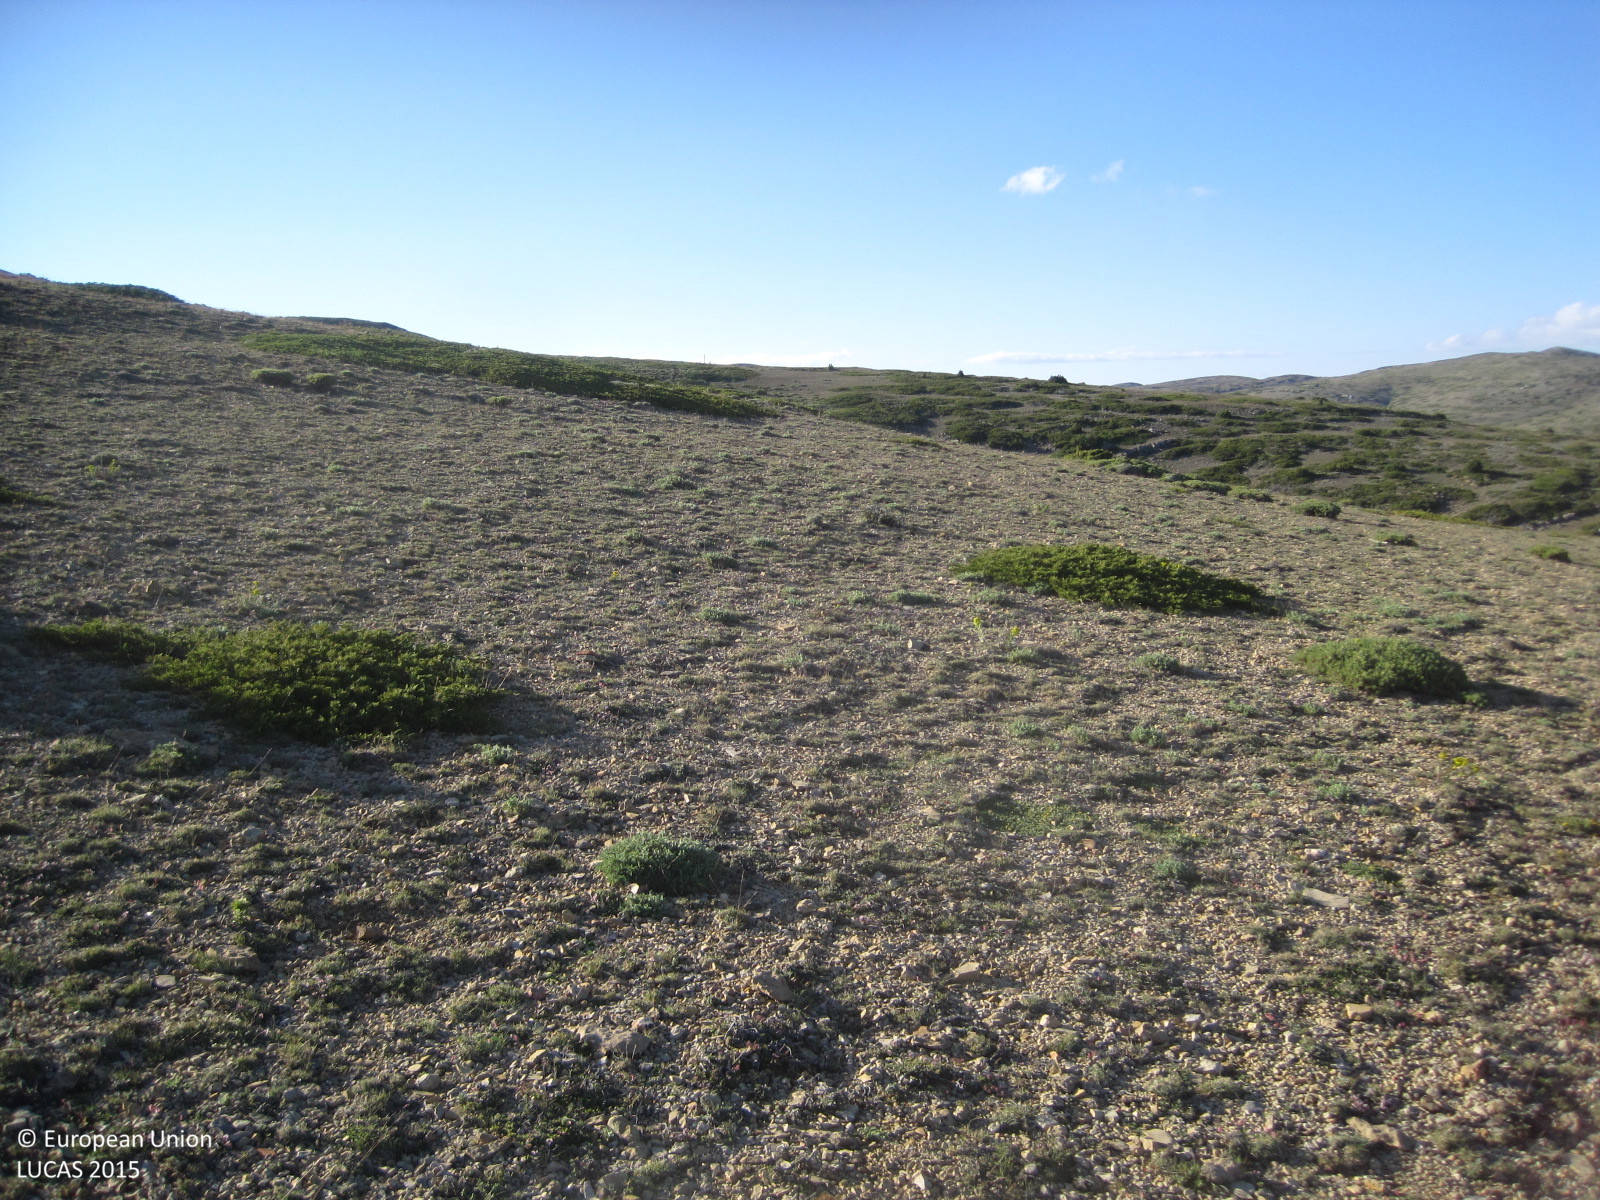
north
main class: Grassland
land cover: Grassland without tree/shrub cover
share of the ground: 50 - 75 %
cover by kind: herbaceous plants 50 %, consolidated bare surface 45 %, shrubs 5 %
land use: Semi-natural and natural areas not in use
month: June
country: ES
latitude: 40.0646
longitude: -1.0162
